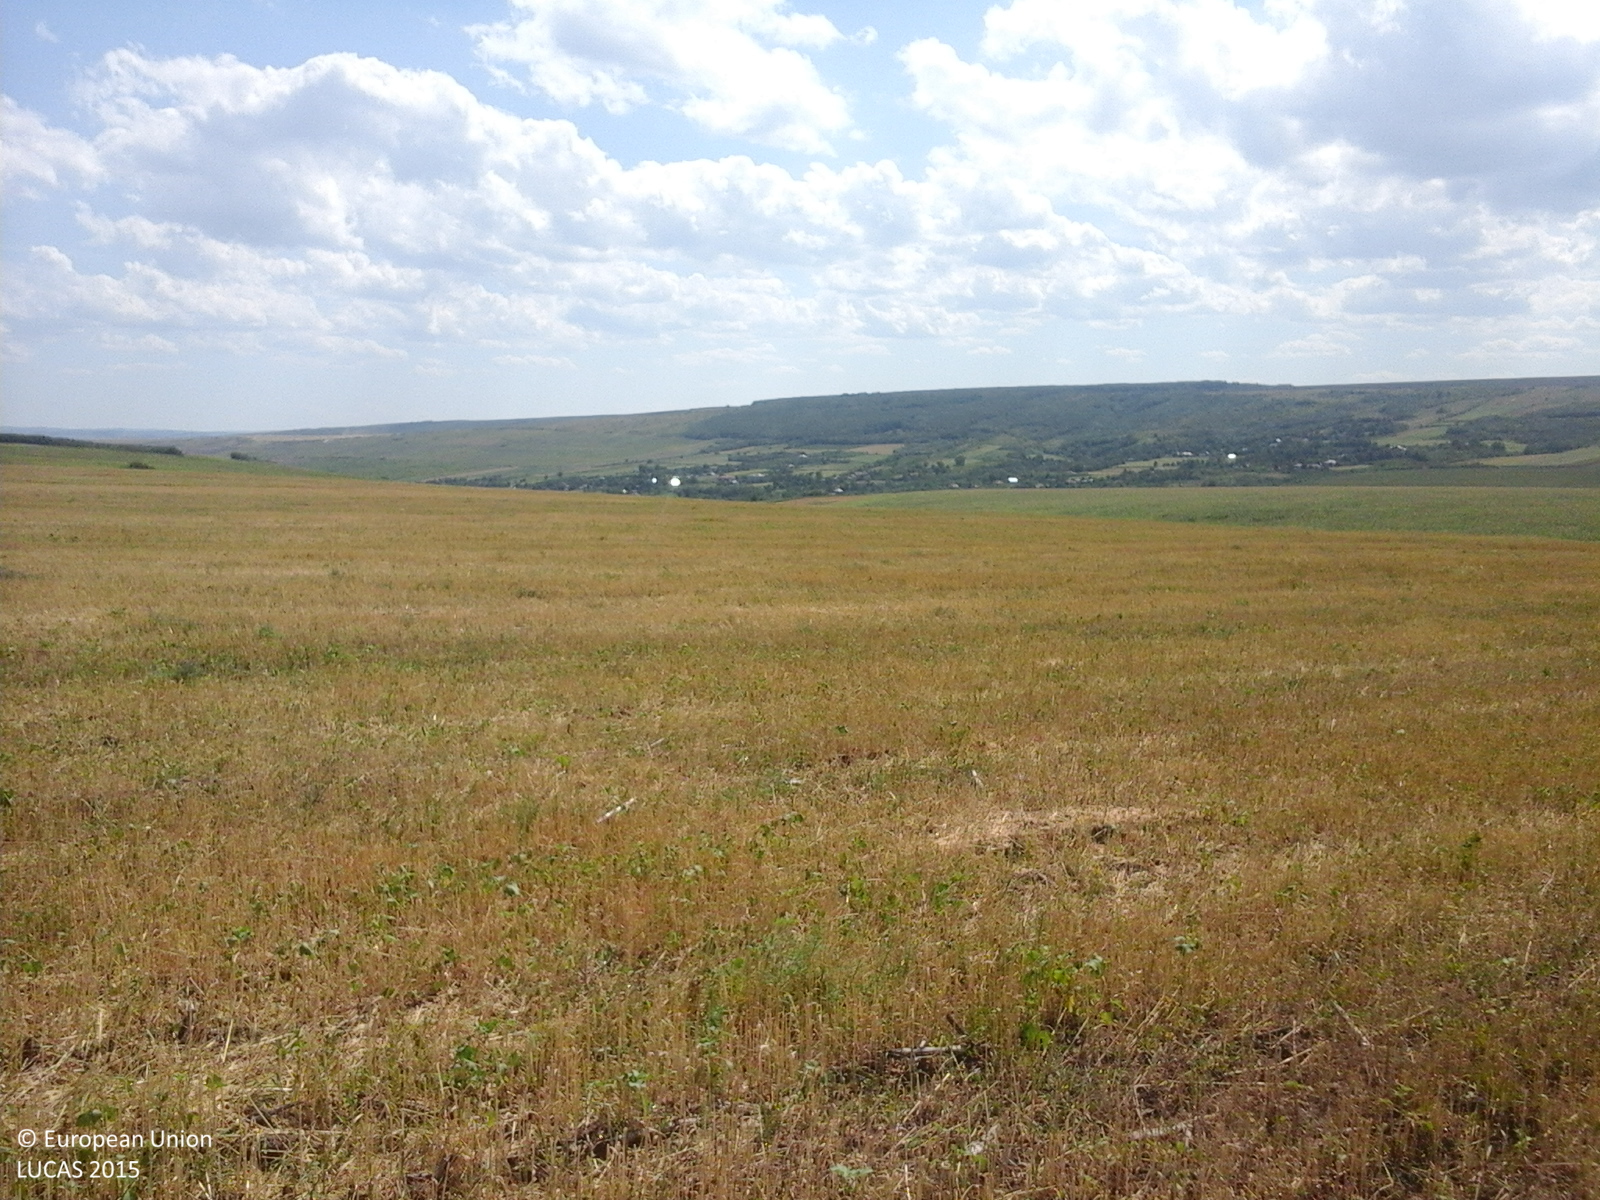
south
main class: Cropland
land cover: Common wheat
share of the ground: 10 - 25 %
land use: Agriculture (excluding fallow land and kitchen gardens)
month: July
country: RO
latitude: 46.4658
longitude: 27.7904
